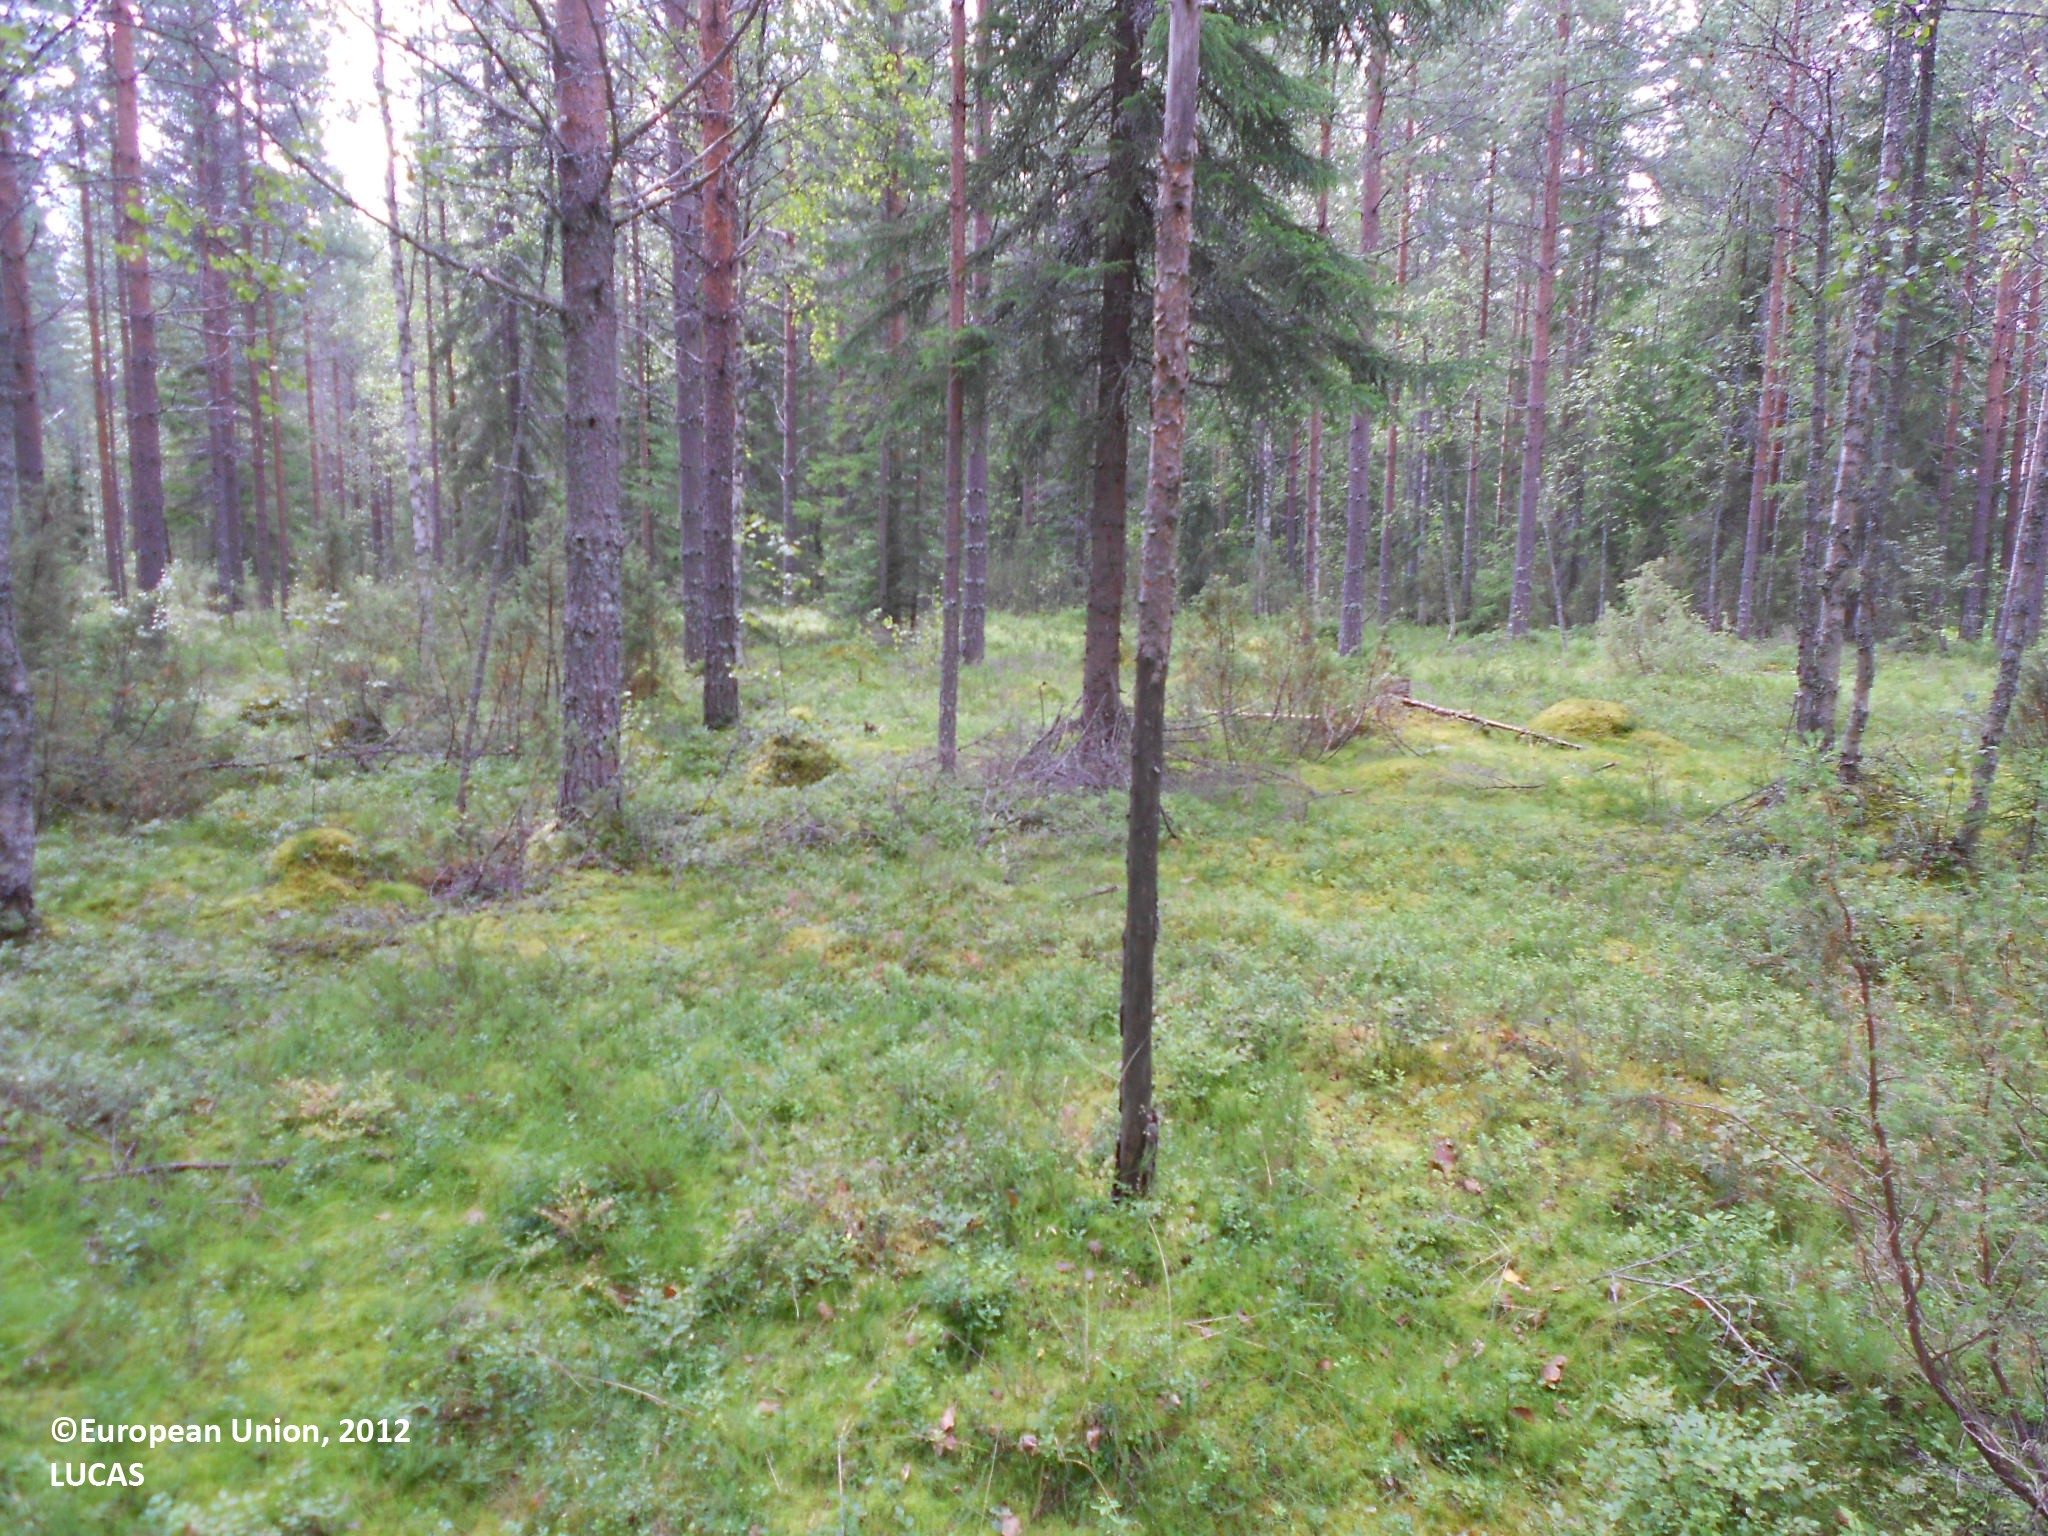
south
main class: Woodland
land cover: Pine dominated coniferous woodland
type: boreal forest
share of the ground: 50 - 75 %
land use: Forestry
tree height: > 5 m
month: August
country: FI
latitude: 63.6154
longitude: 28.3133
